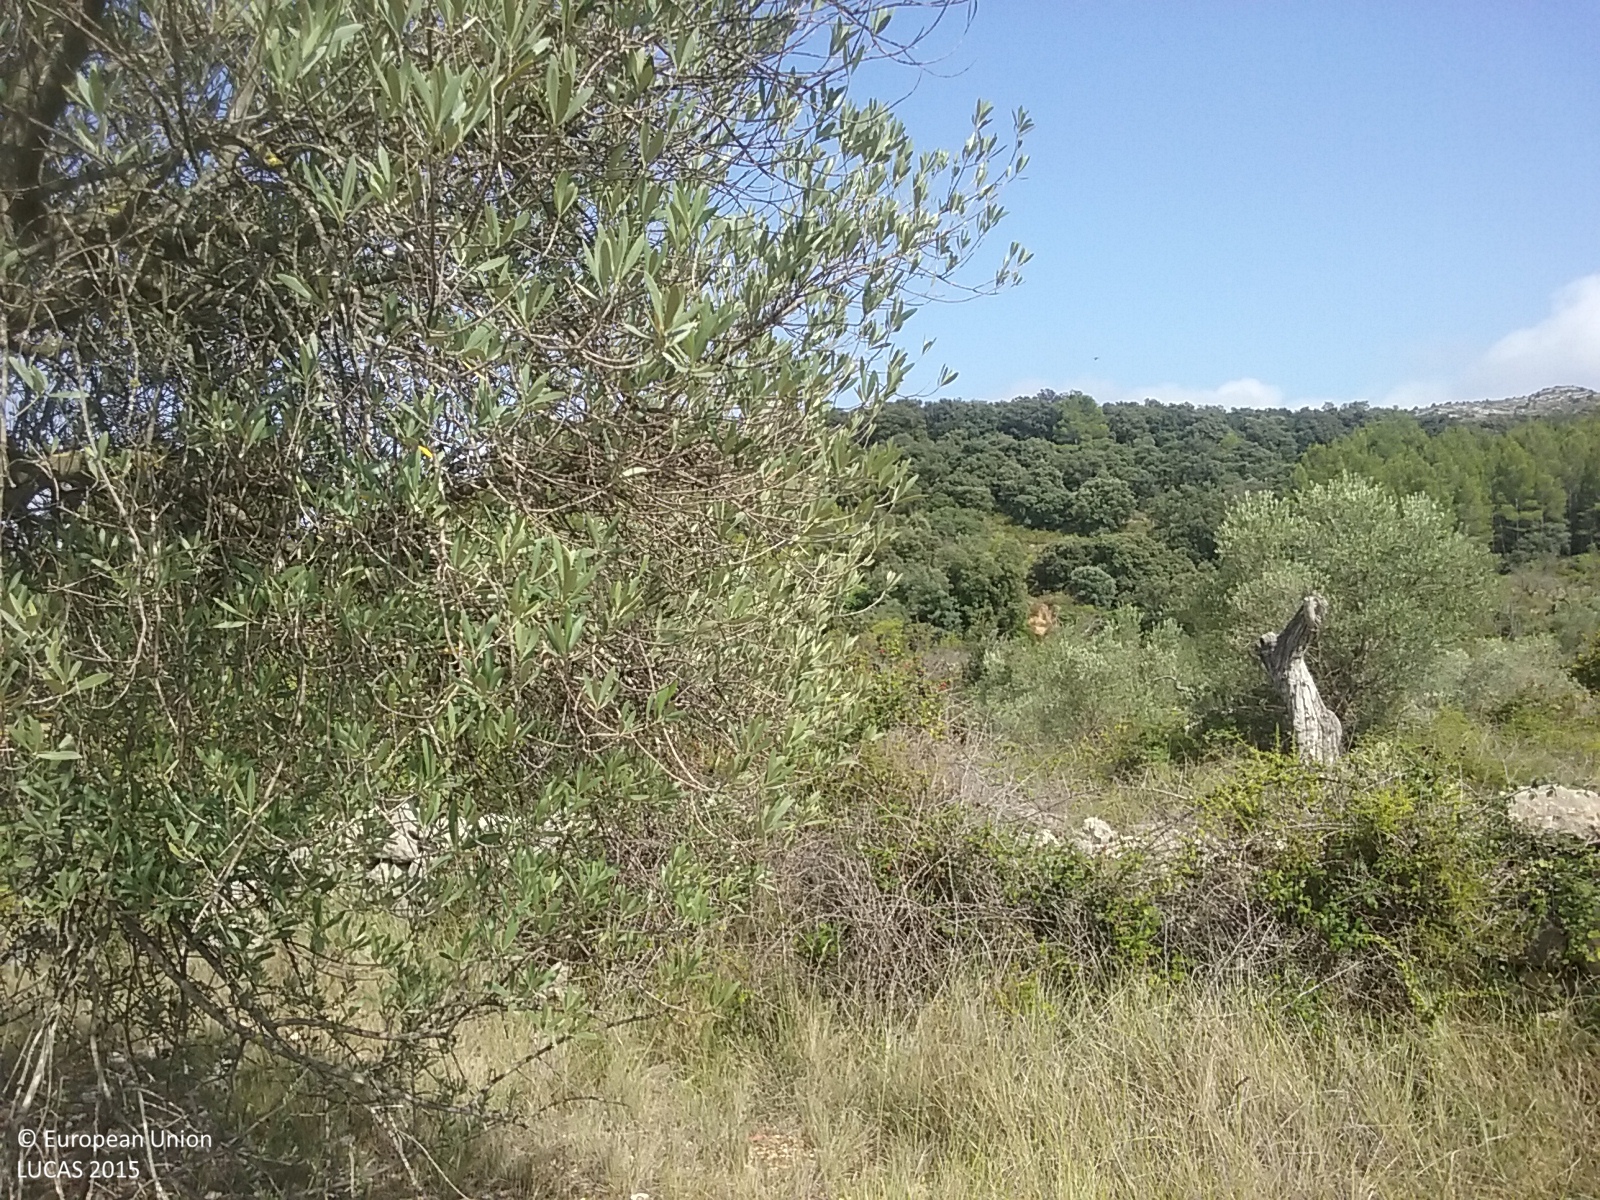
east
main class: Cropland
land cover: Olive groves
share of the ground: 25 - 50 %
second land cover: Spontaneously vegetated surfaces
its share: 25 - 50 %
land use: Agriculture (excluding fallow land and kitchen gardens)
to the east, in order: Olive groves; Spontaneously vegetated surfaces; Dry stone walls; Olive groves; Shruby margins; Dry stone walls; Olive groves; Shrubland without tree cover; Nuts trees; Shruby margins; Nuts trees; Shrubland without tree cover; Nuts trees; Shrubland without tree cover; Nuts trees; Shrubland without tree cover; Nuts trees; Pine dominated coniferous woodland
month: August
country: ES
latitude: 40.3383
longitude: 0.0018
